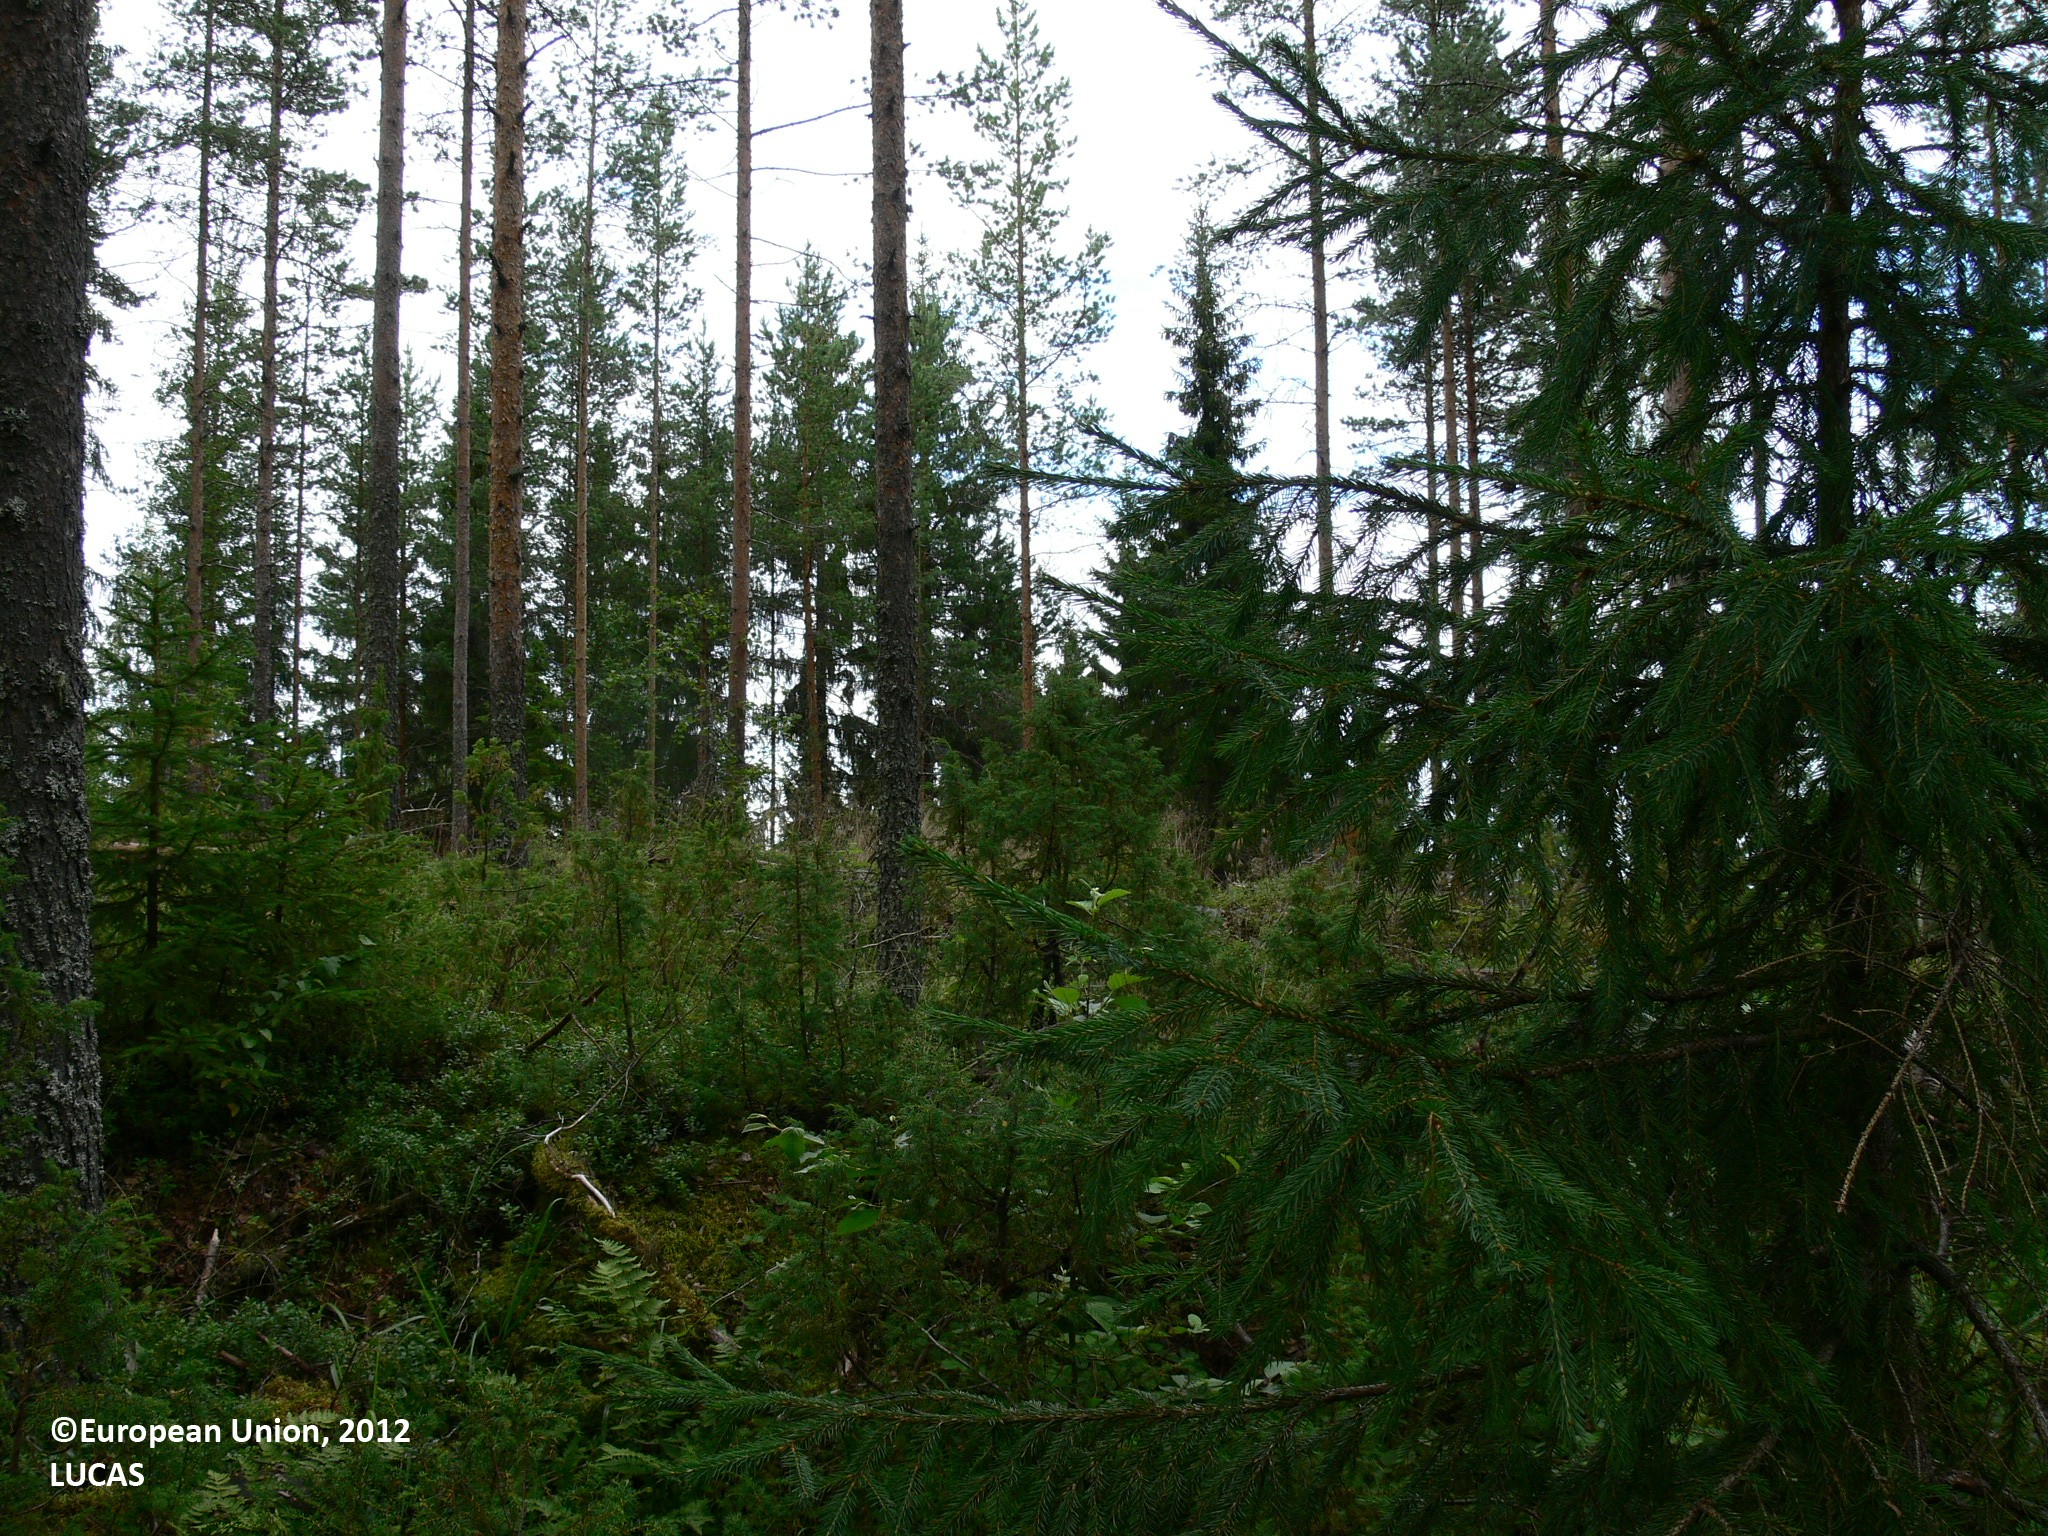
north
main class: Woodland
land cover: Other mixed woodland
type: boreal forest
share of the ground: 50 - 75 %
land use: Forestry
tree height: > 5 m
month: July
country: FI
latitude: 63.1808
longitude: 29.3984
